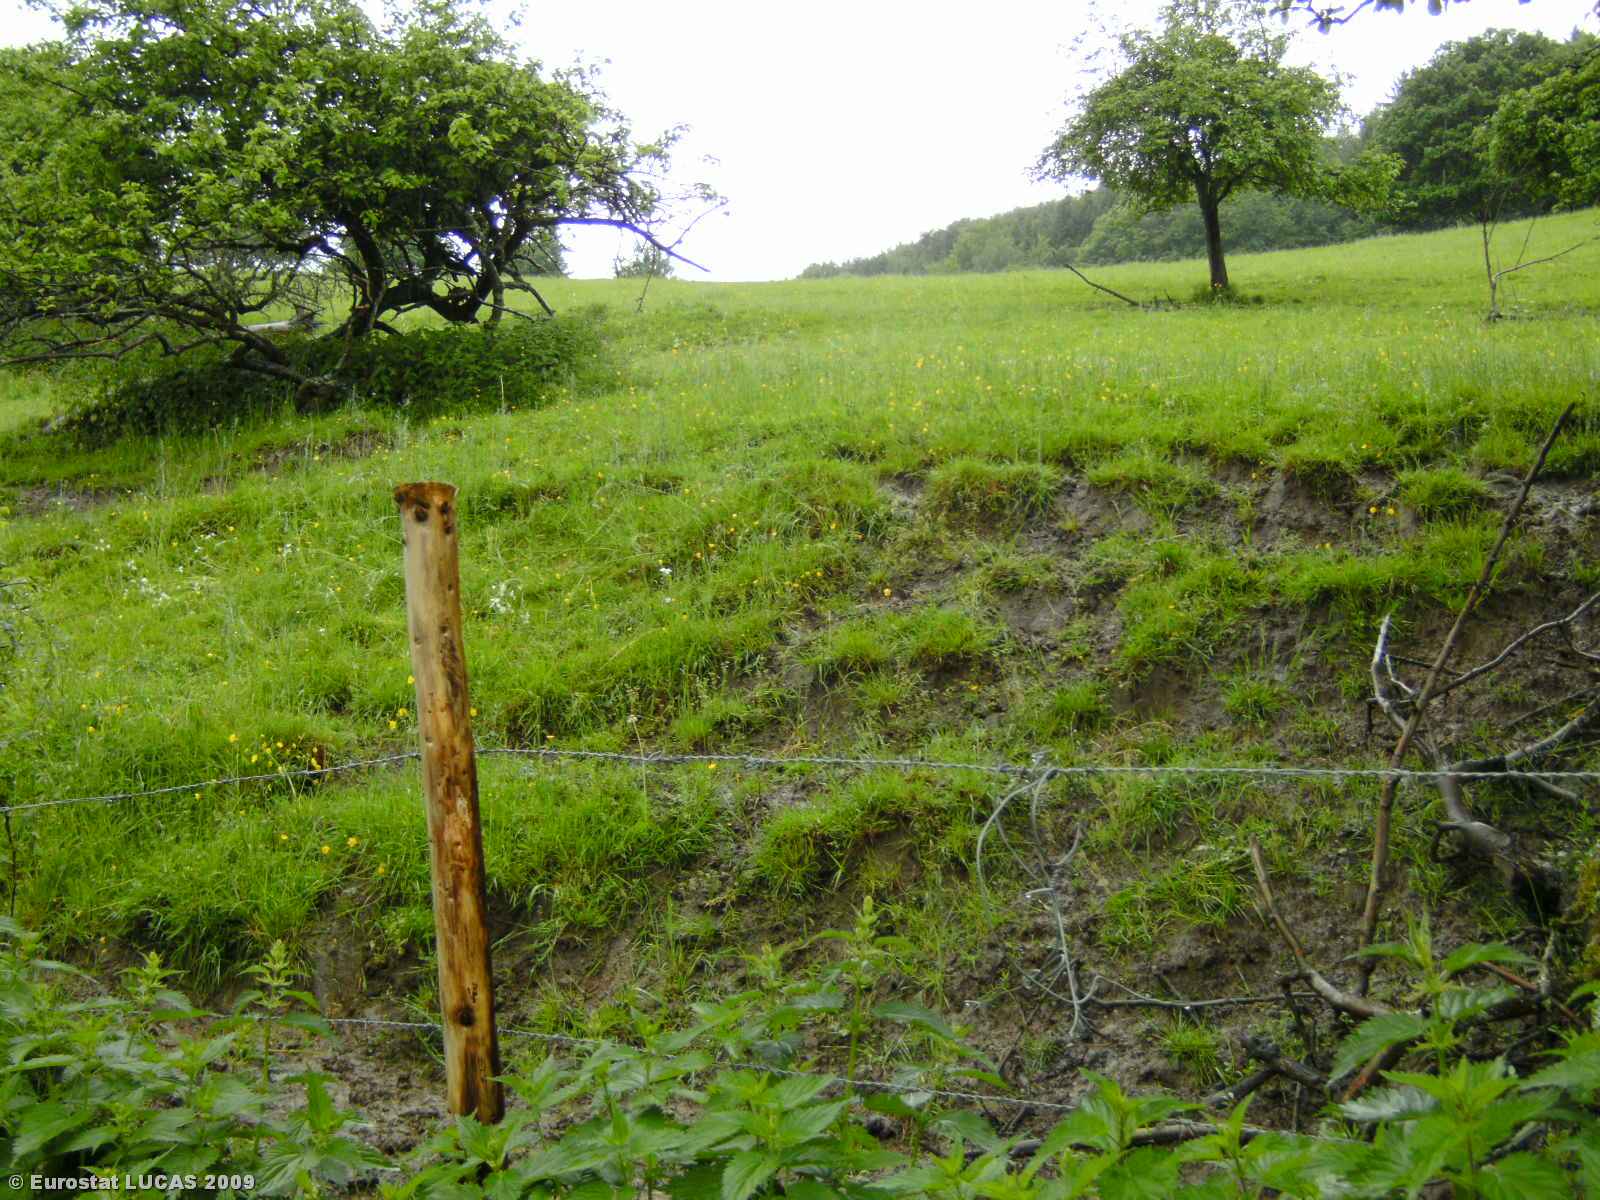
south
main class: Grassland
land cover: Grassland without tree/shrub cover
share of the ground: > 75 %
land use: Agriculture (excluding fallow land and kitchen gardens)
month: May
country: LU
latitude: 49.8547
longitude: 6.3136
